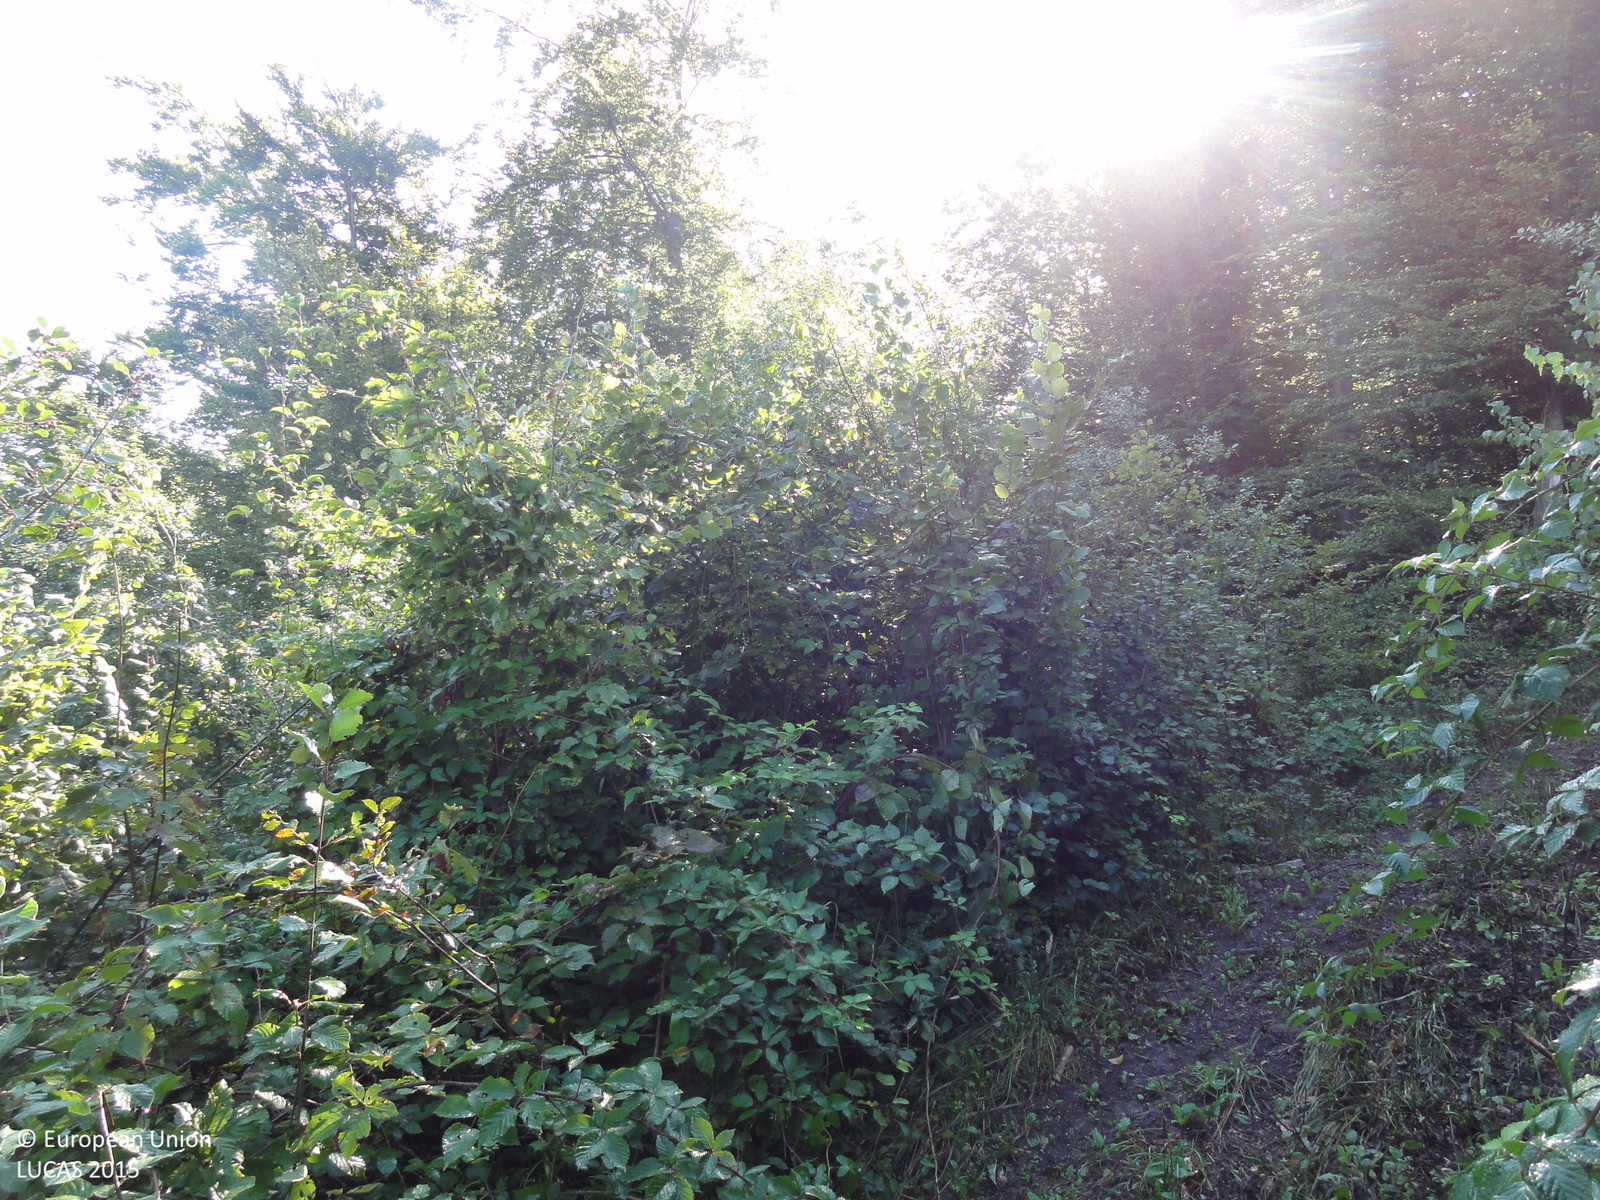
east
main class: Shrubland
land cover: Shrubland with sparse tree cover
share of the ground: > 75 %
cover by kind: shrubs 90 %, broadleaved forest trees 5 %, herbaceous plants 5 %
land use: Semi-natural and natural areas not in use
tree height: > 5 m
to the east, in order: Shrubland with sparse tree cover; Tracks; Shrubland with sparse tree cover; Broadleaved woodland; Grassland without tree/shrub cover; Broadleaved woodland
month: September
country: SI
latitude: 45.9400
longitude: 15.1175
